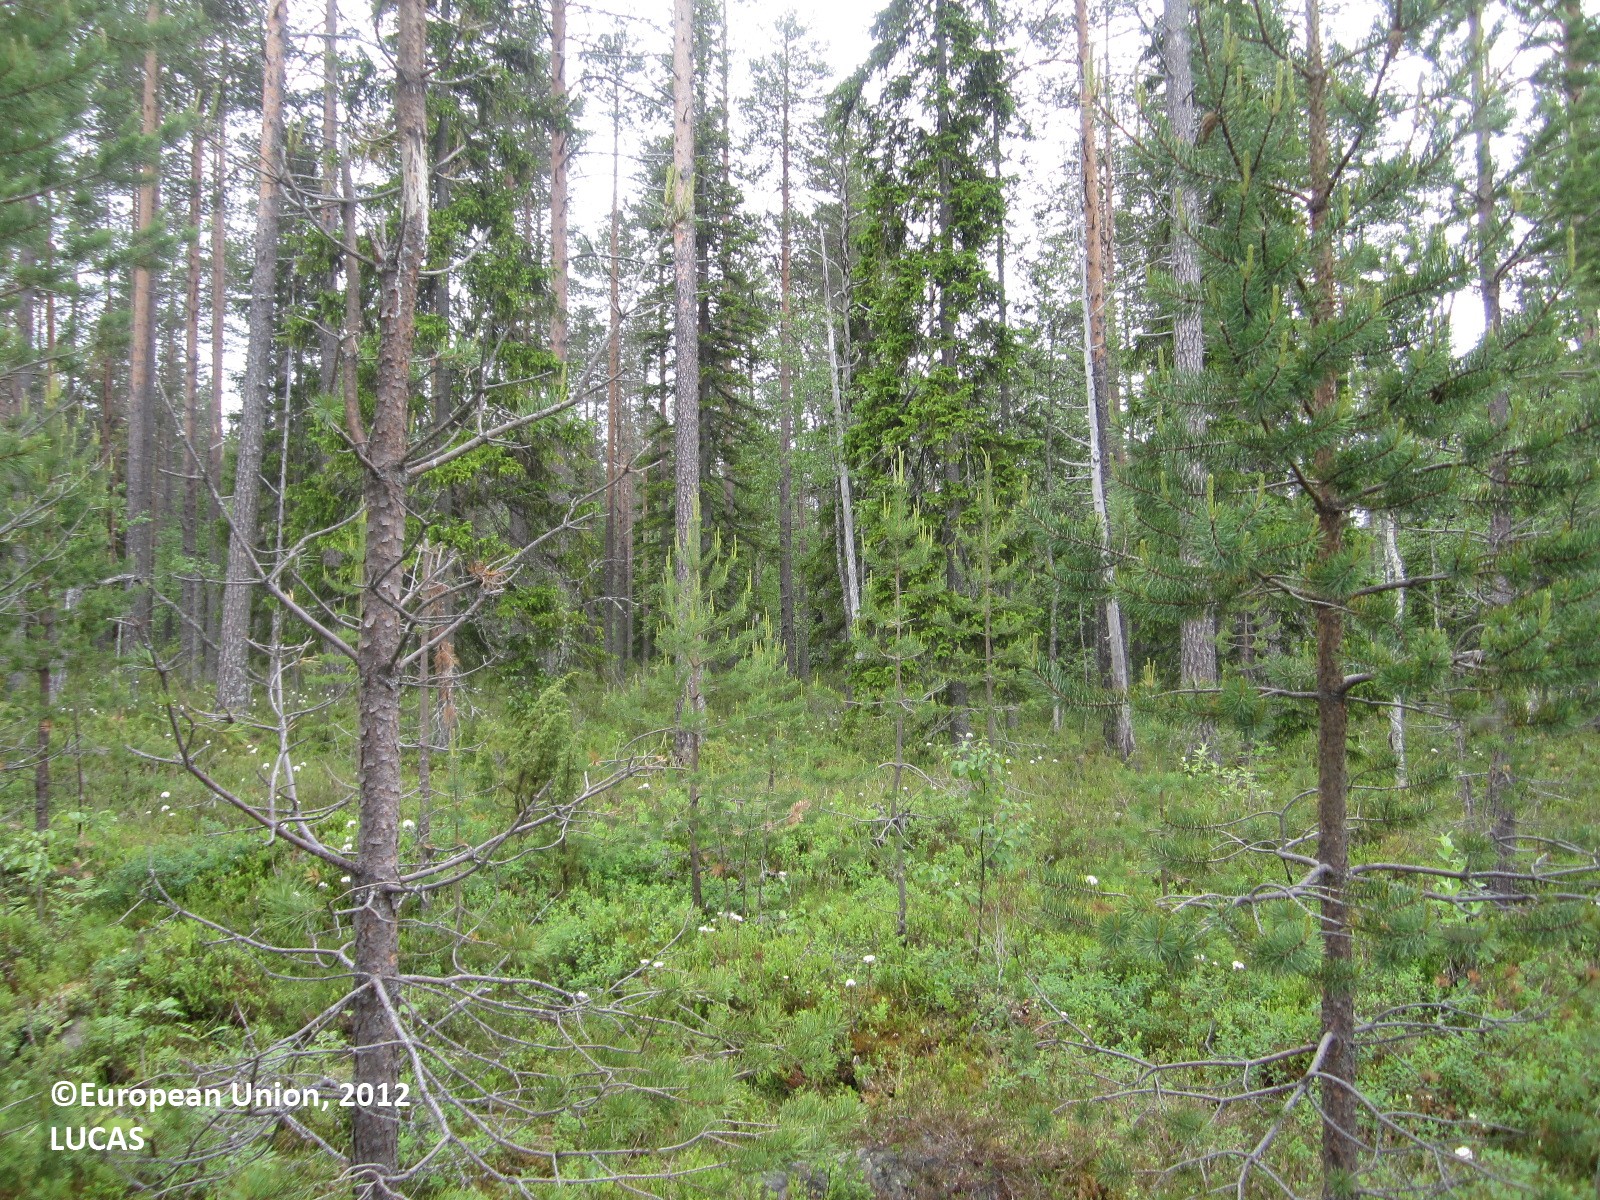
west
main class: Woodland
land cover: Pine dominated coniferous woodland
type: boreal forest
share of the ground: 25 - 50 %
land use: Forestry
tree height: > 5 m
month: June
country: FI
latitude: 64.7253
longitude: 29.9389
